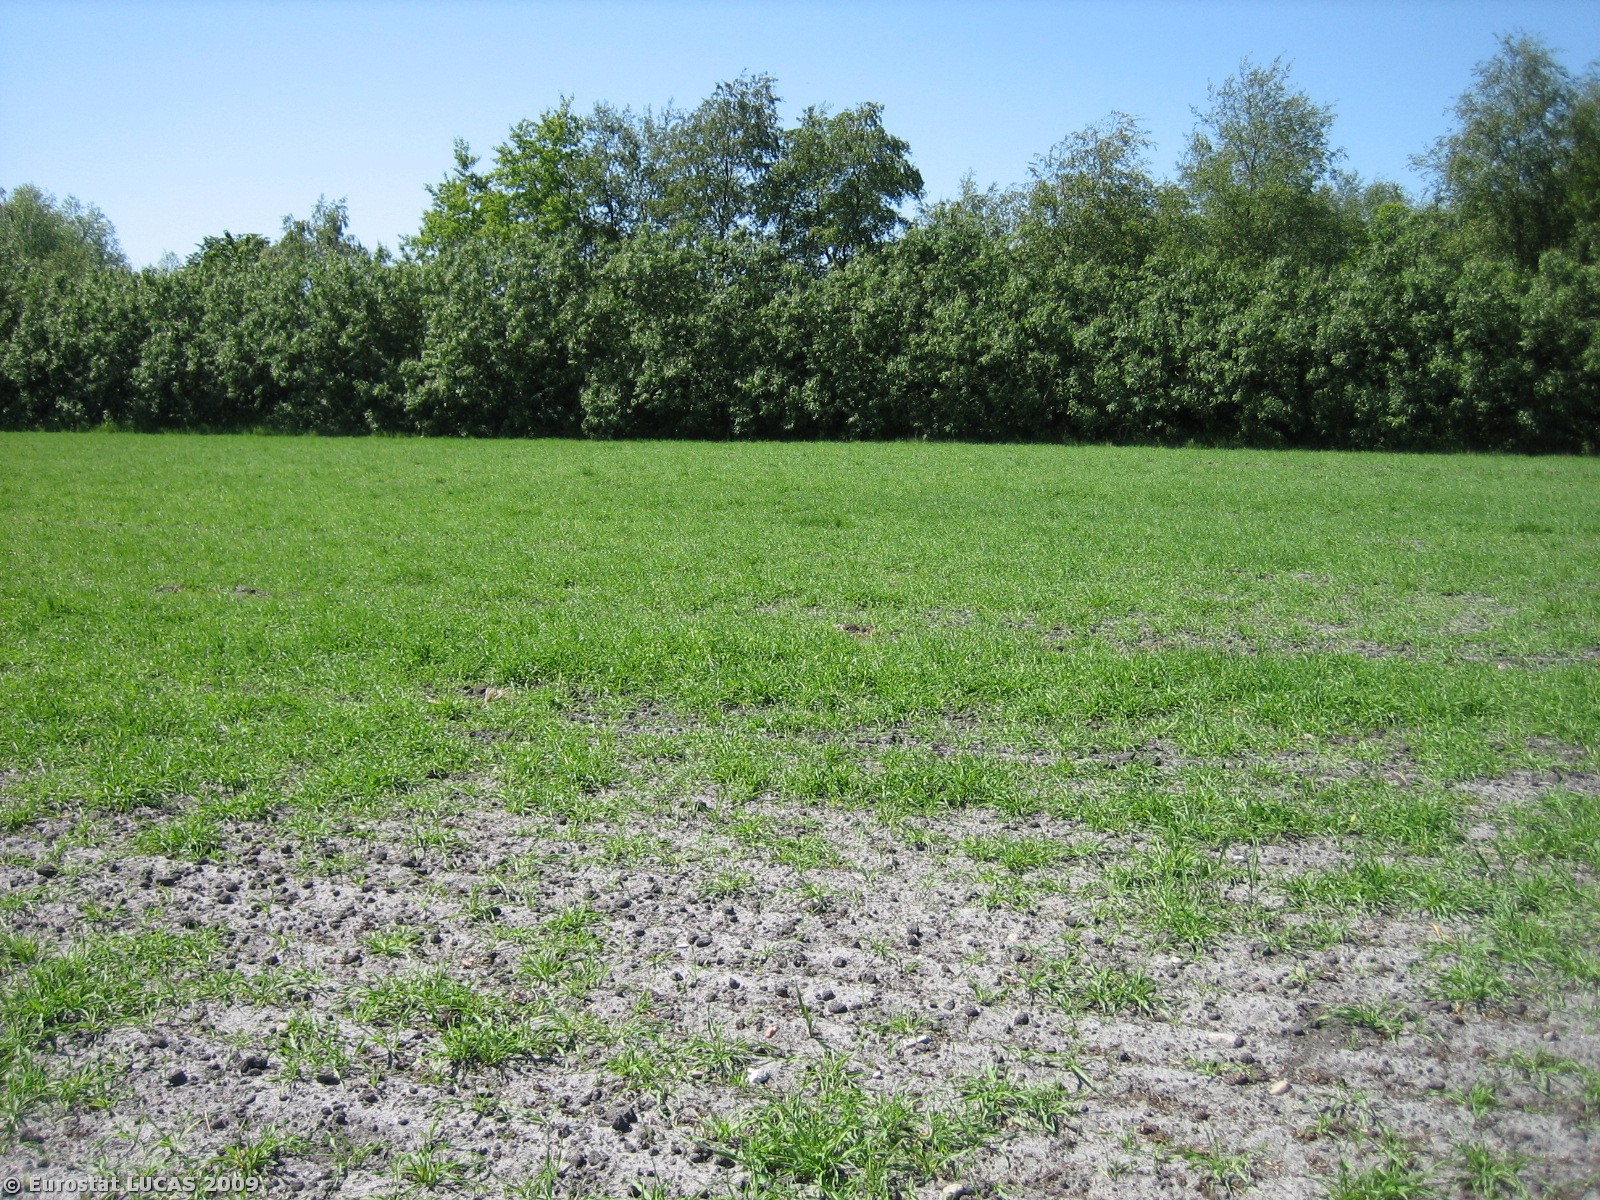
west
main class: Cropland
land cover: Barley
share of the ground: 50 - 75 %
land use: Agriculture (excluding fallow land and kitchen gardens)
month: May
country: DK
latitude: 55.8951
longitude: 8.8658
